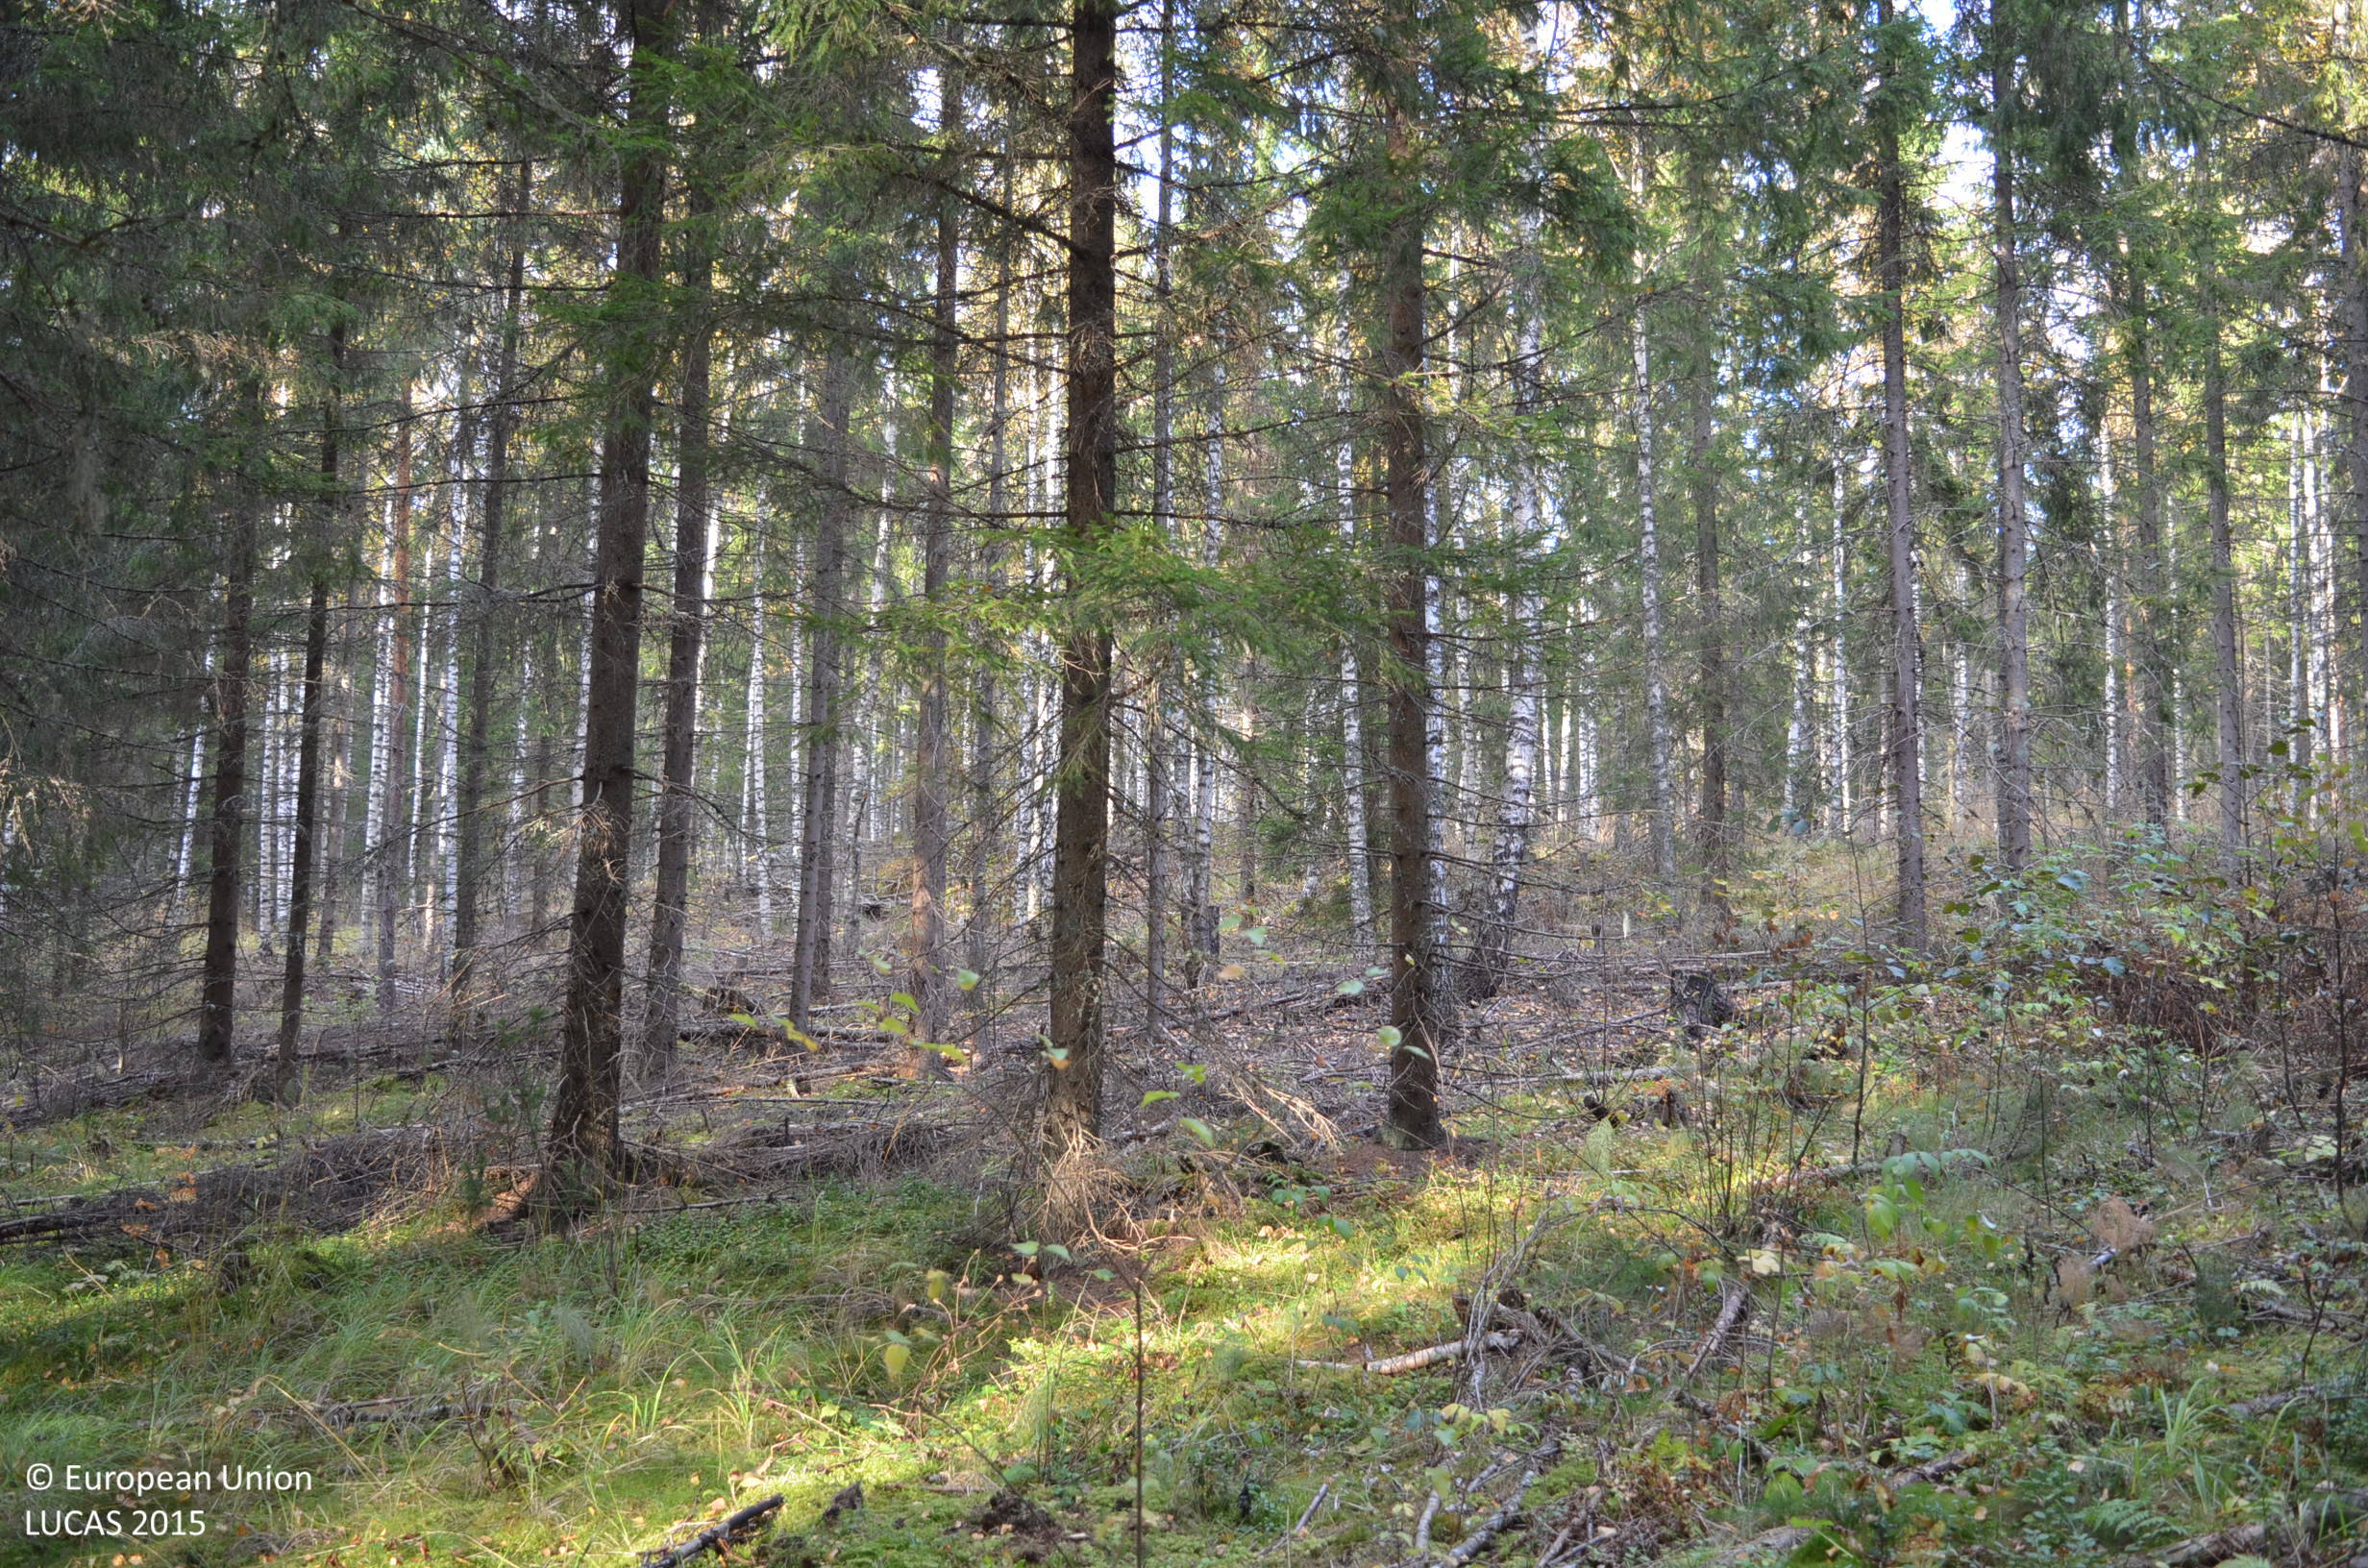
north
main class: Woodland
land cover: Spruce dominated coniferous woodland
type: boreal forest
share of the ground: > 75 %
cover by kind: coniferous forest trees 70 %, broadleaved forest trees 5 %, shrubs 5 %, herbaceous plants 5 %, lichens and mosses 5 %
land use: Forestry
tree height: > 5 m
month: October
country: FI
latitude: 61.7125
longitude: 23.8355
